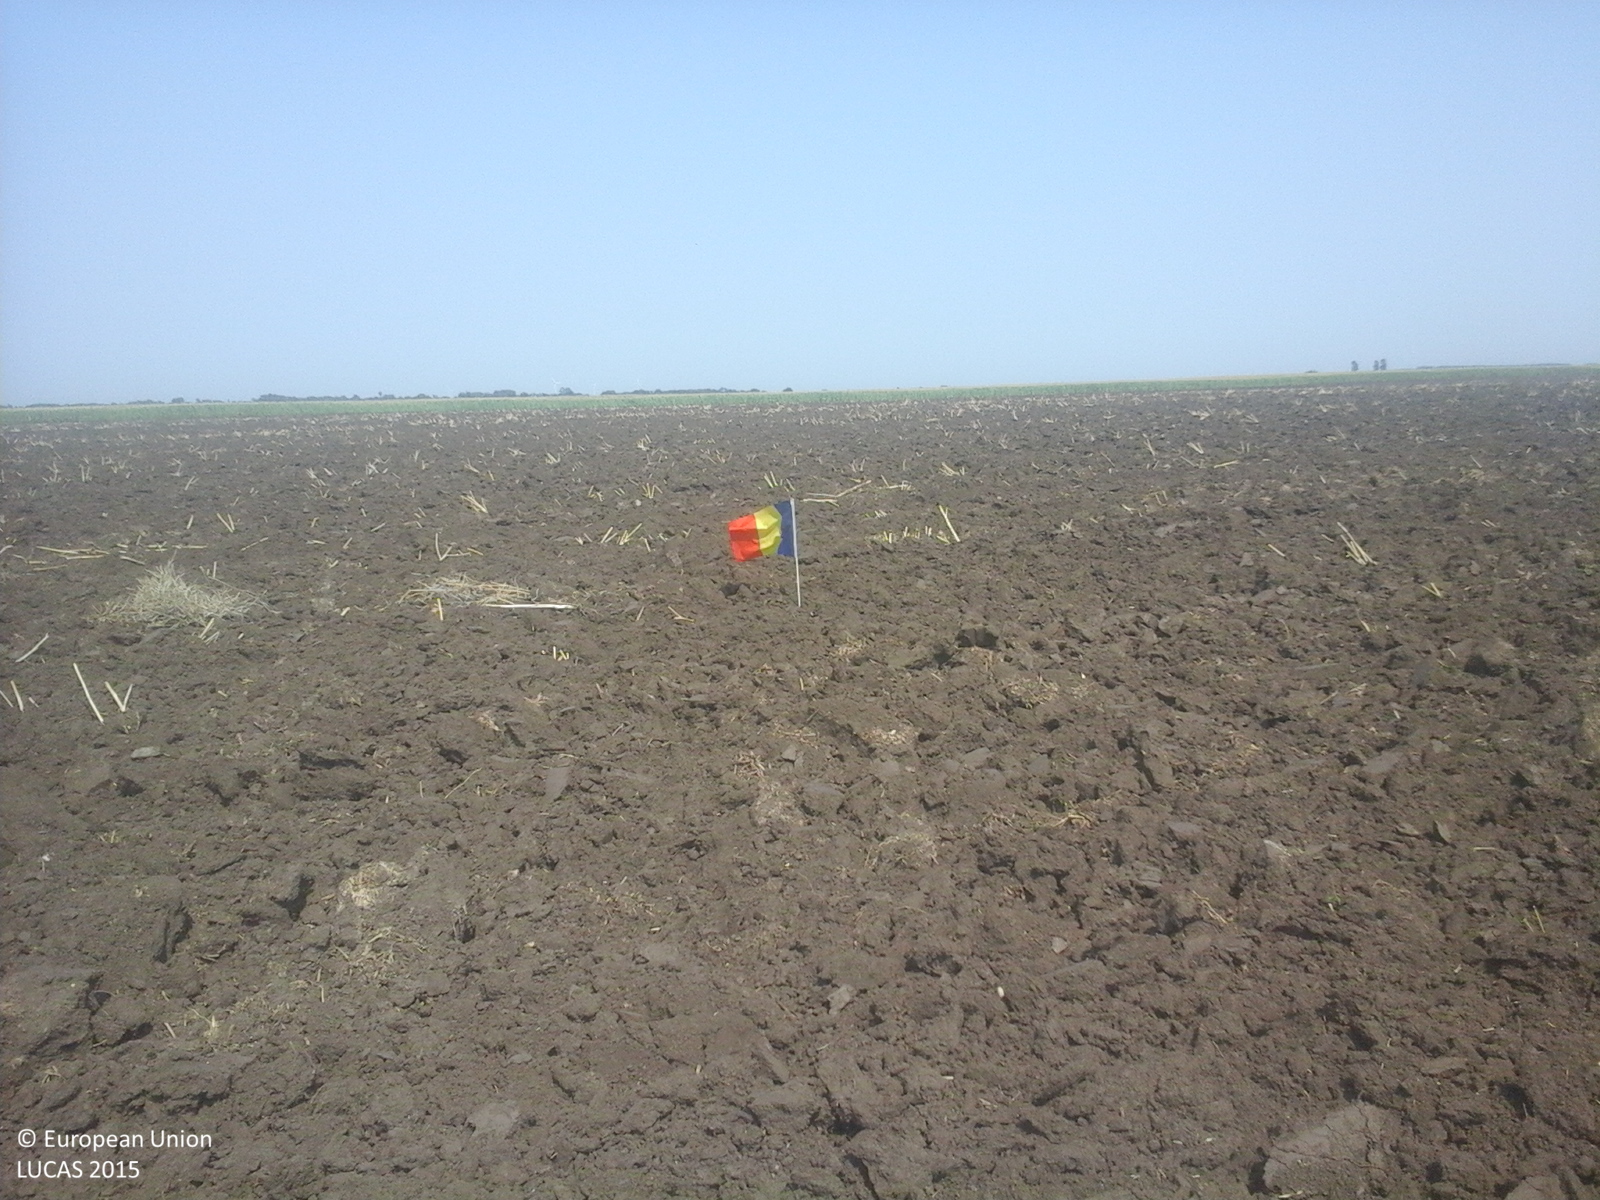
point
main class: Cropland
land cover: Rape and turnip rape
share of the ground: < 10 %
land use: Agriculture (excluding fallow land and kitchen gardens)
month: July
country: RO
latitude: 44.9124
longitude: 26.8360
